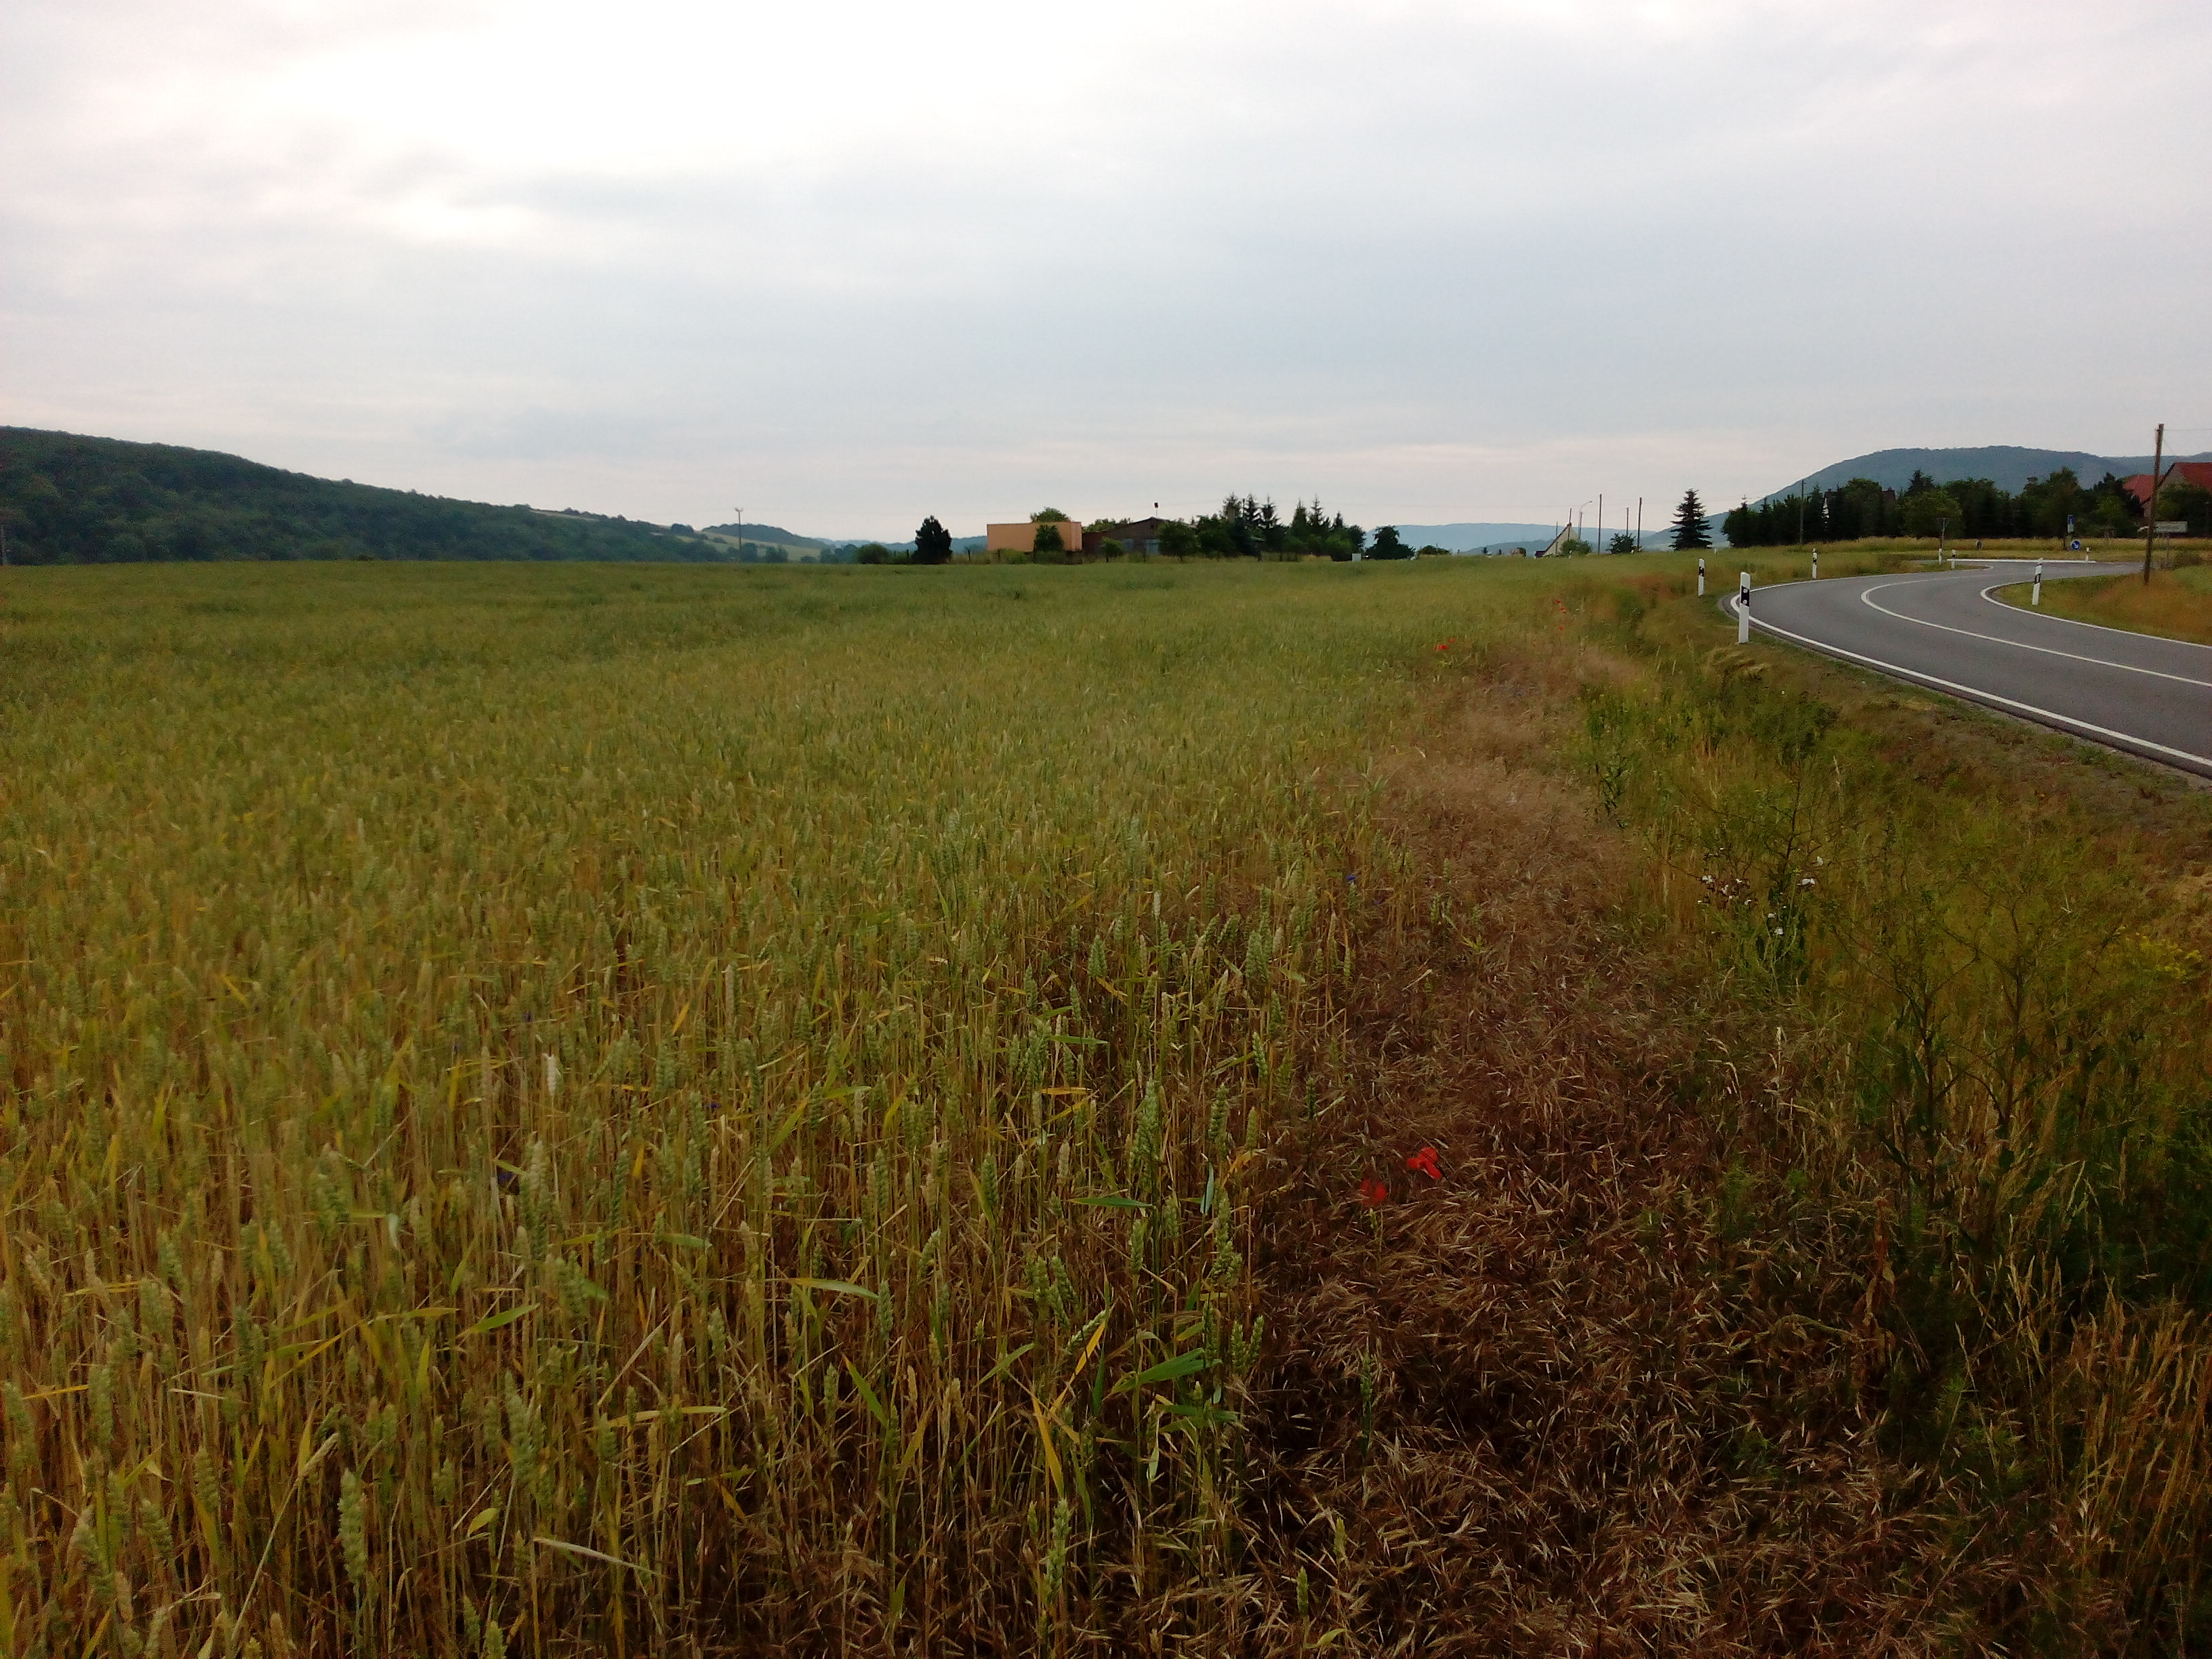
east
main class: Cropland
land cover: Common wheat
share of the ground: > 75 %
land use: Agriculture (excluding fallow land and kitchen gardens)
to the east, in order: Common wheat; Electric lines; Common wheat
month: June
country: DE
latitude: 51.3489
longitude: 10.9617
